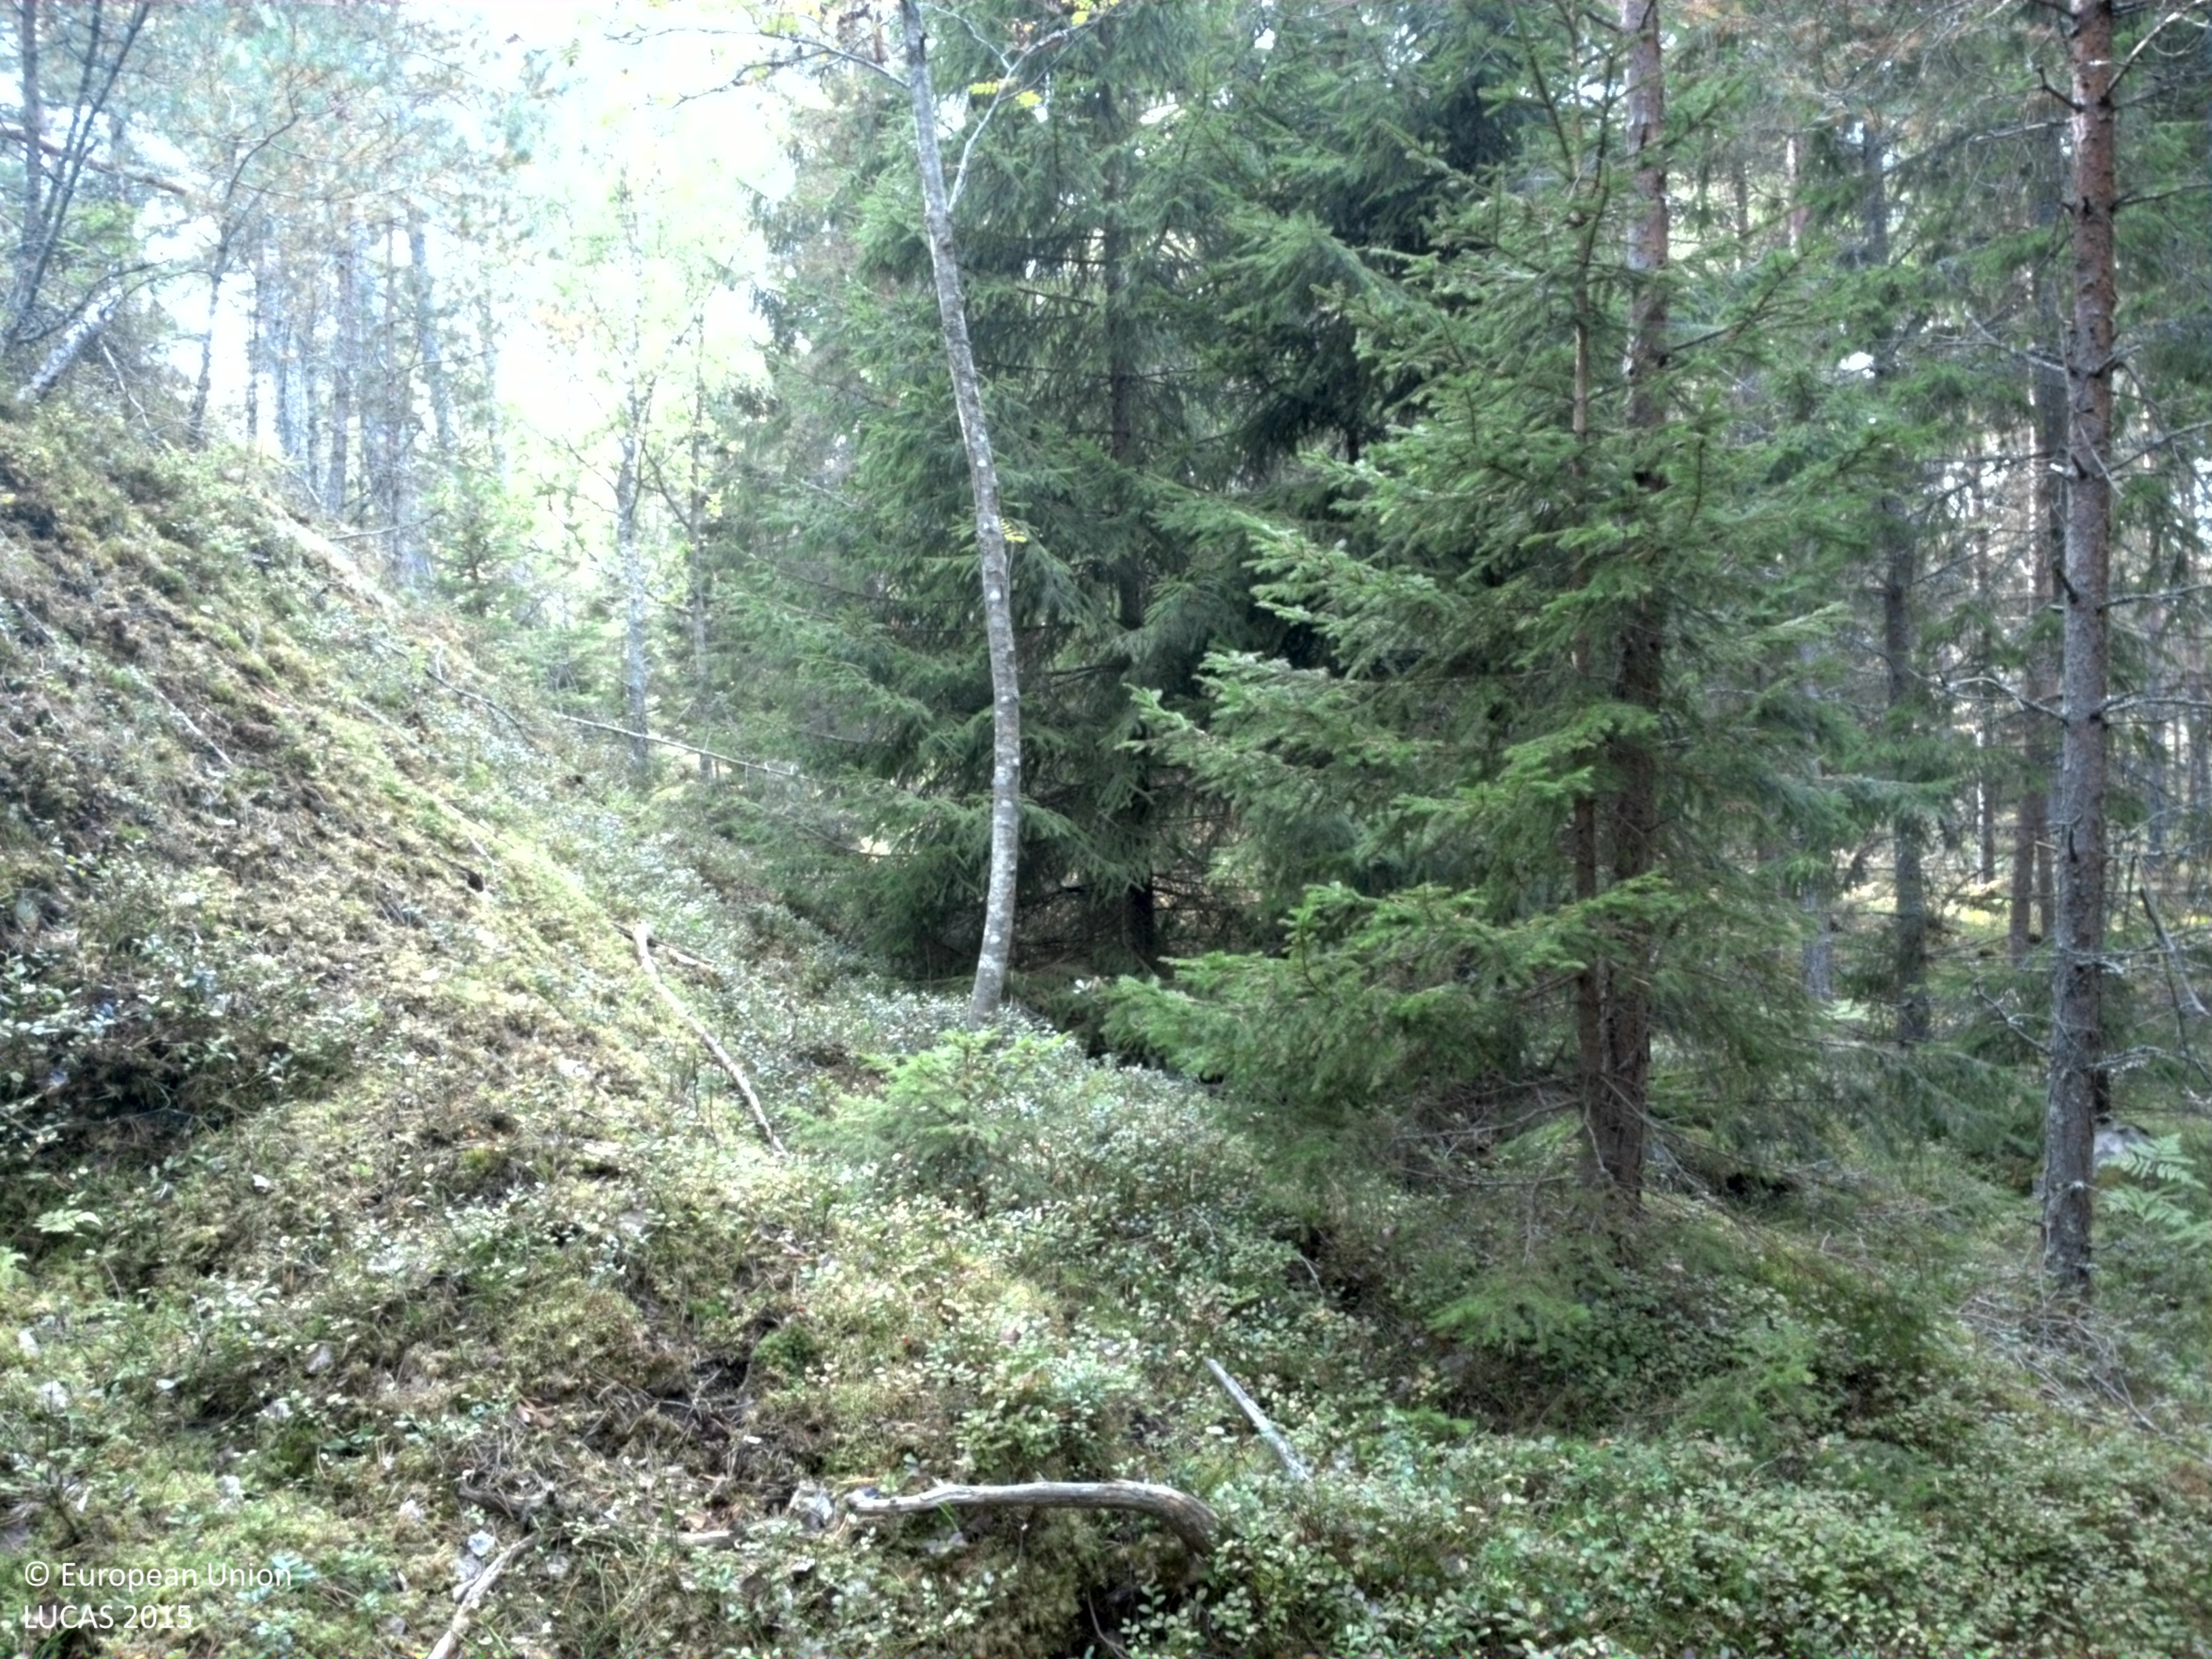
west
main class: Woodland
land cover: Pine dominated coniferous woodland
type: boreal forest
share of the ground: 50 - 75 %
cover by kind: coniferous forest trees 65 %, lichens and mosses 35 %
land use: Forestry
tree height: > 5 m
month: September
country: SE
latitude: 59.3781
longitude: 18.5373
